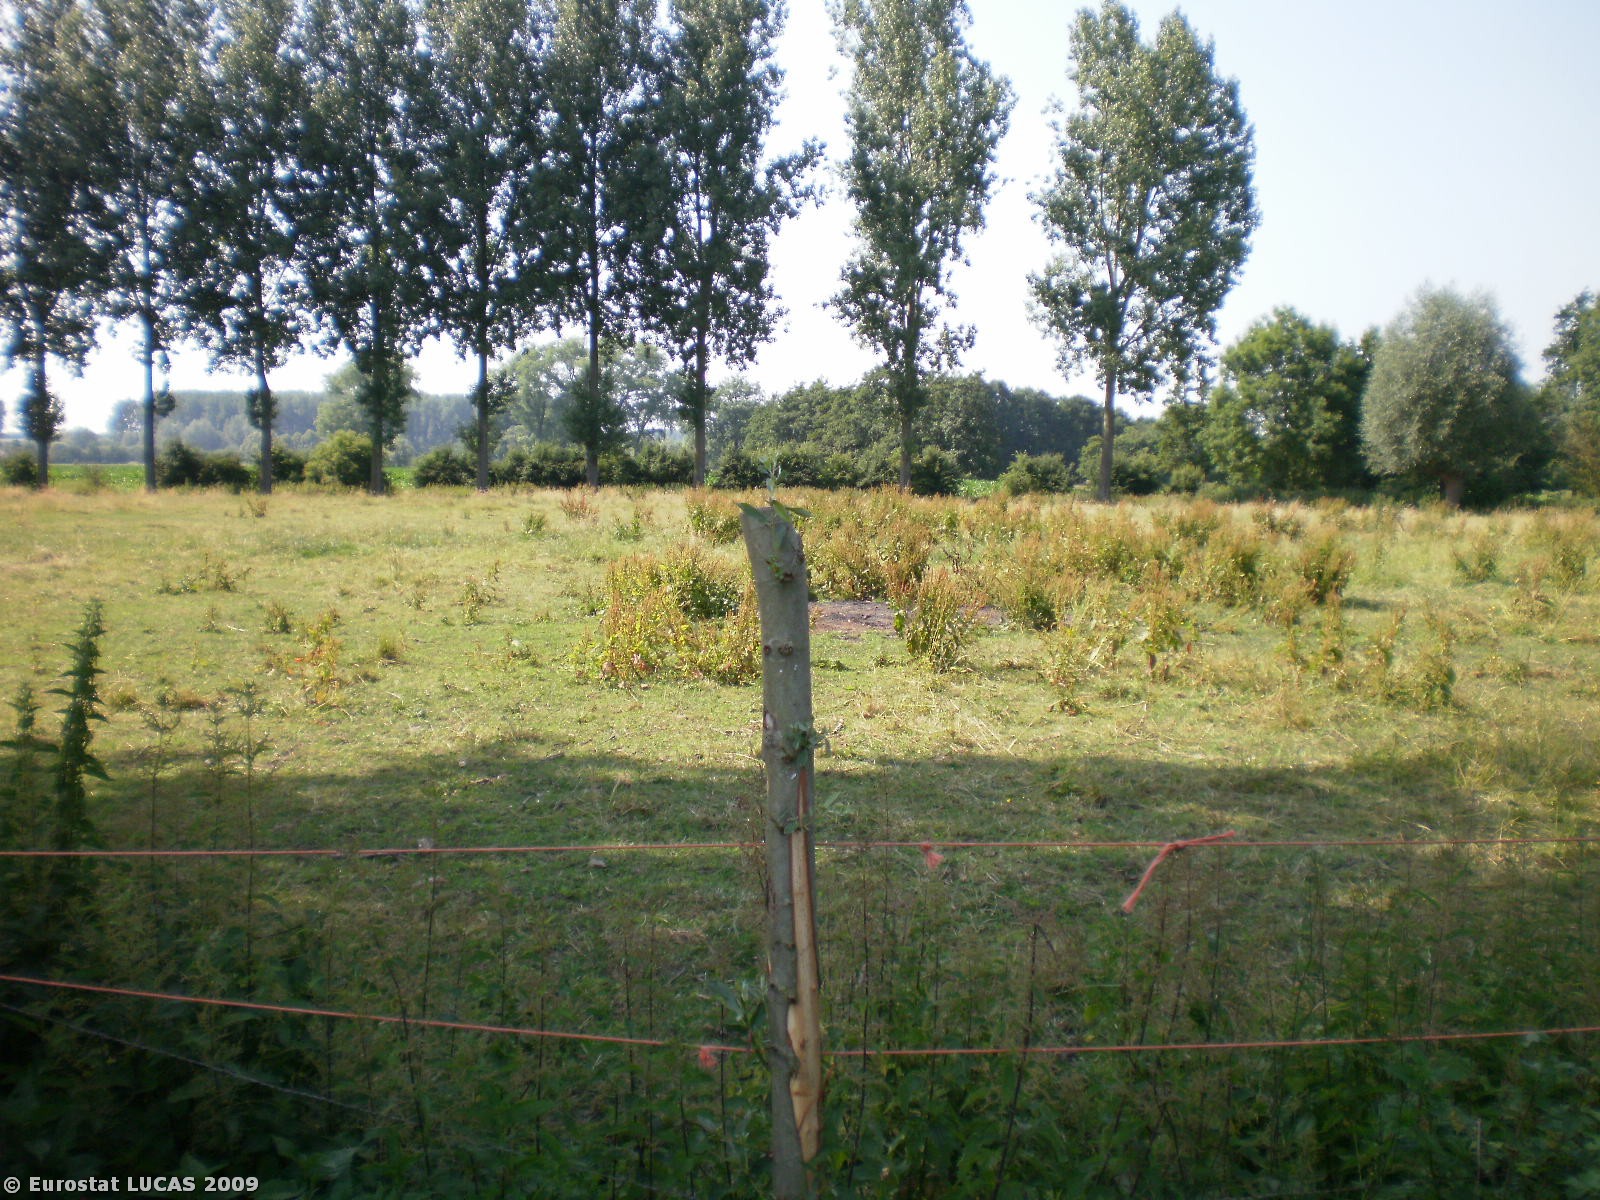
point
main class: Grassland
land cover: Grassland without tree/shrub cover
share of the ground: > 75 %
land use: Agriculture (excluding fallow land and kitchen gardens)
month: May
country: BE
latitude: 50.6653
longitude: 3.8108
